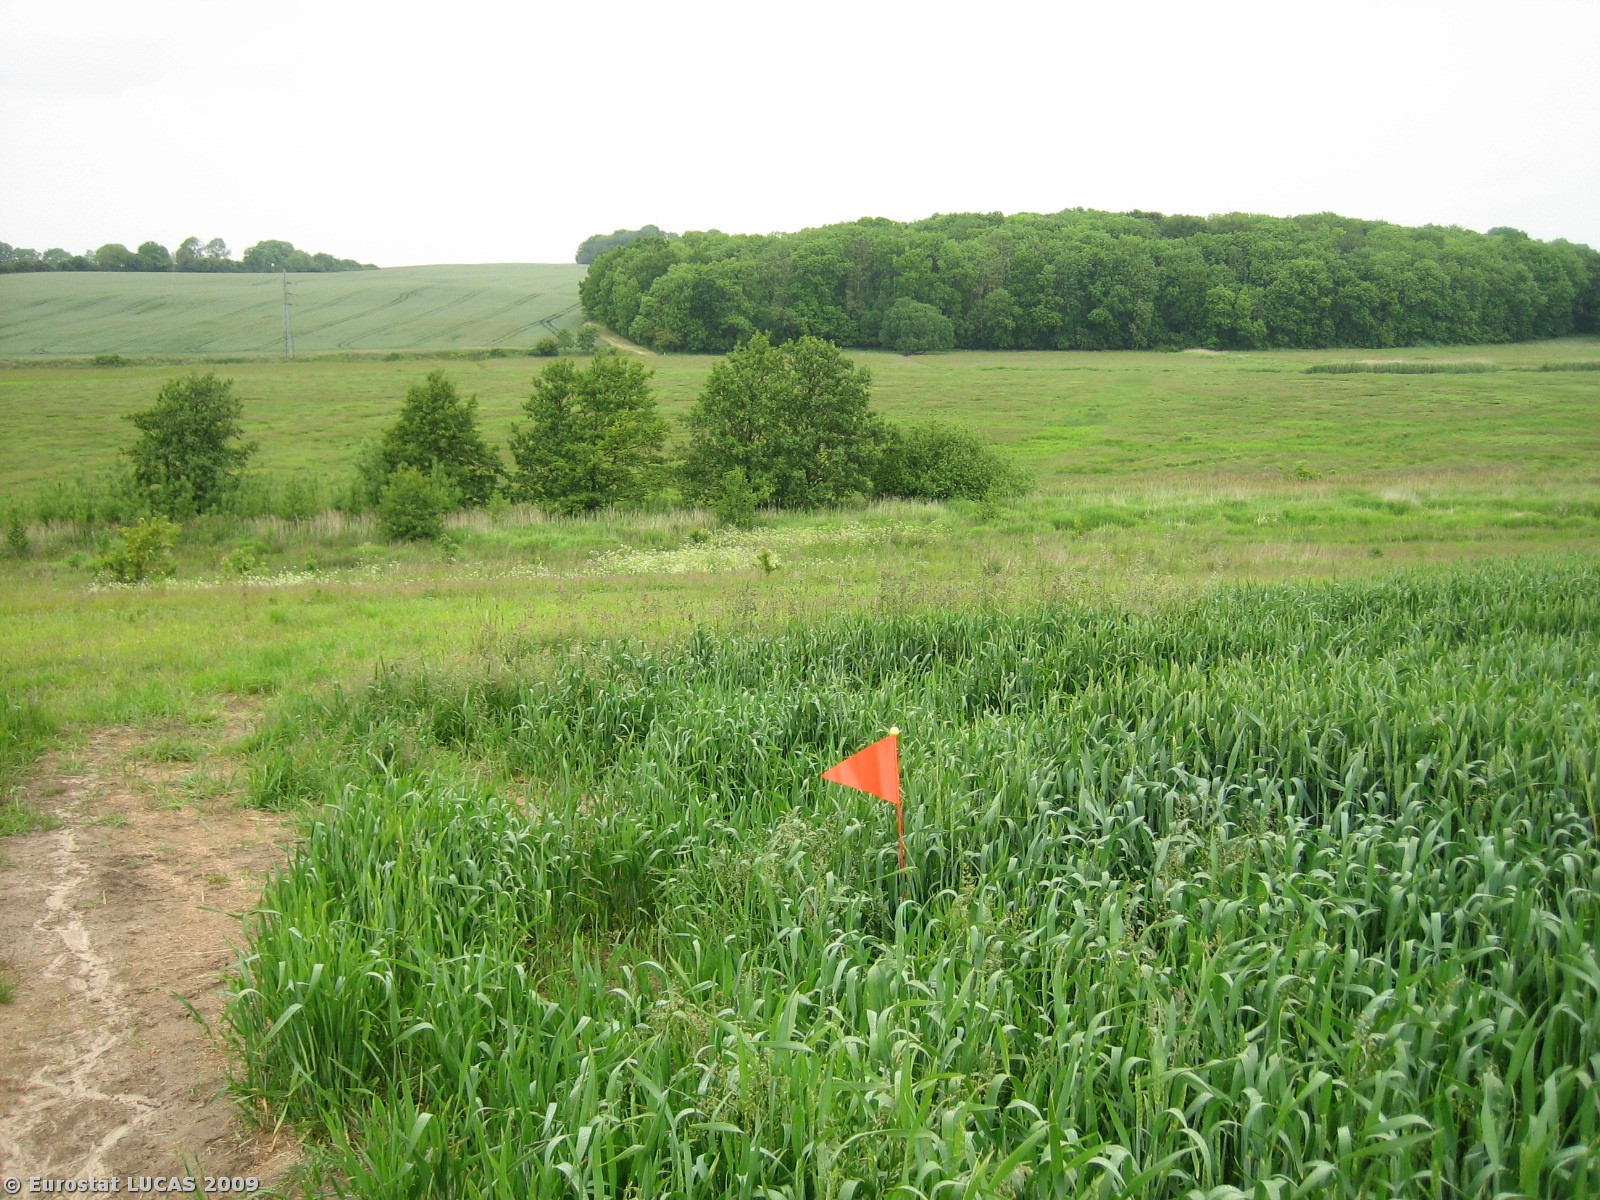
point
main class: Cropland
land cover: Common wheat
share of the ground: > 75 %
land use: Agriculture (excluding fallow land and kitchen gardens)
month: June
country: DK
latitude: 56.0078
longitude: 10.2083
